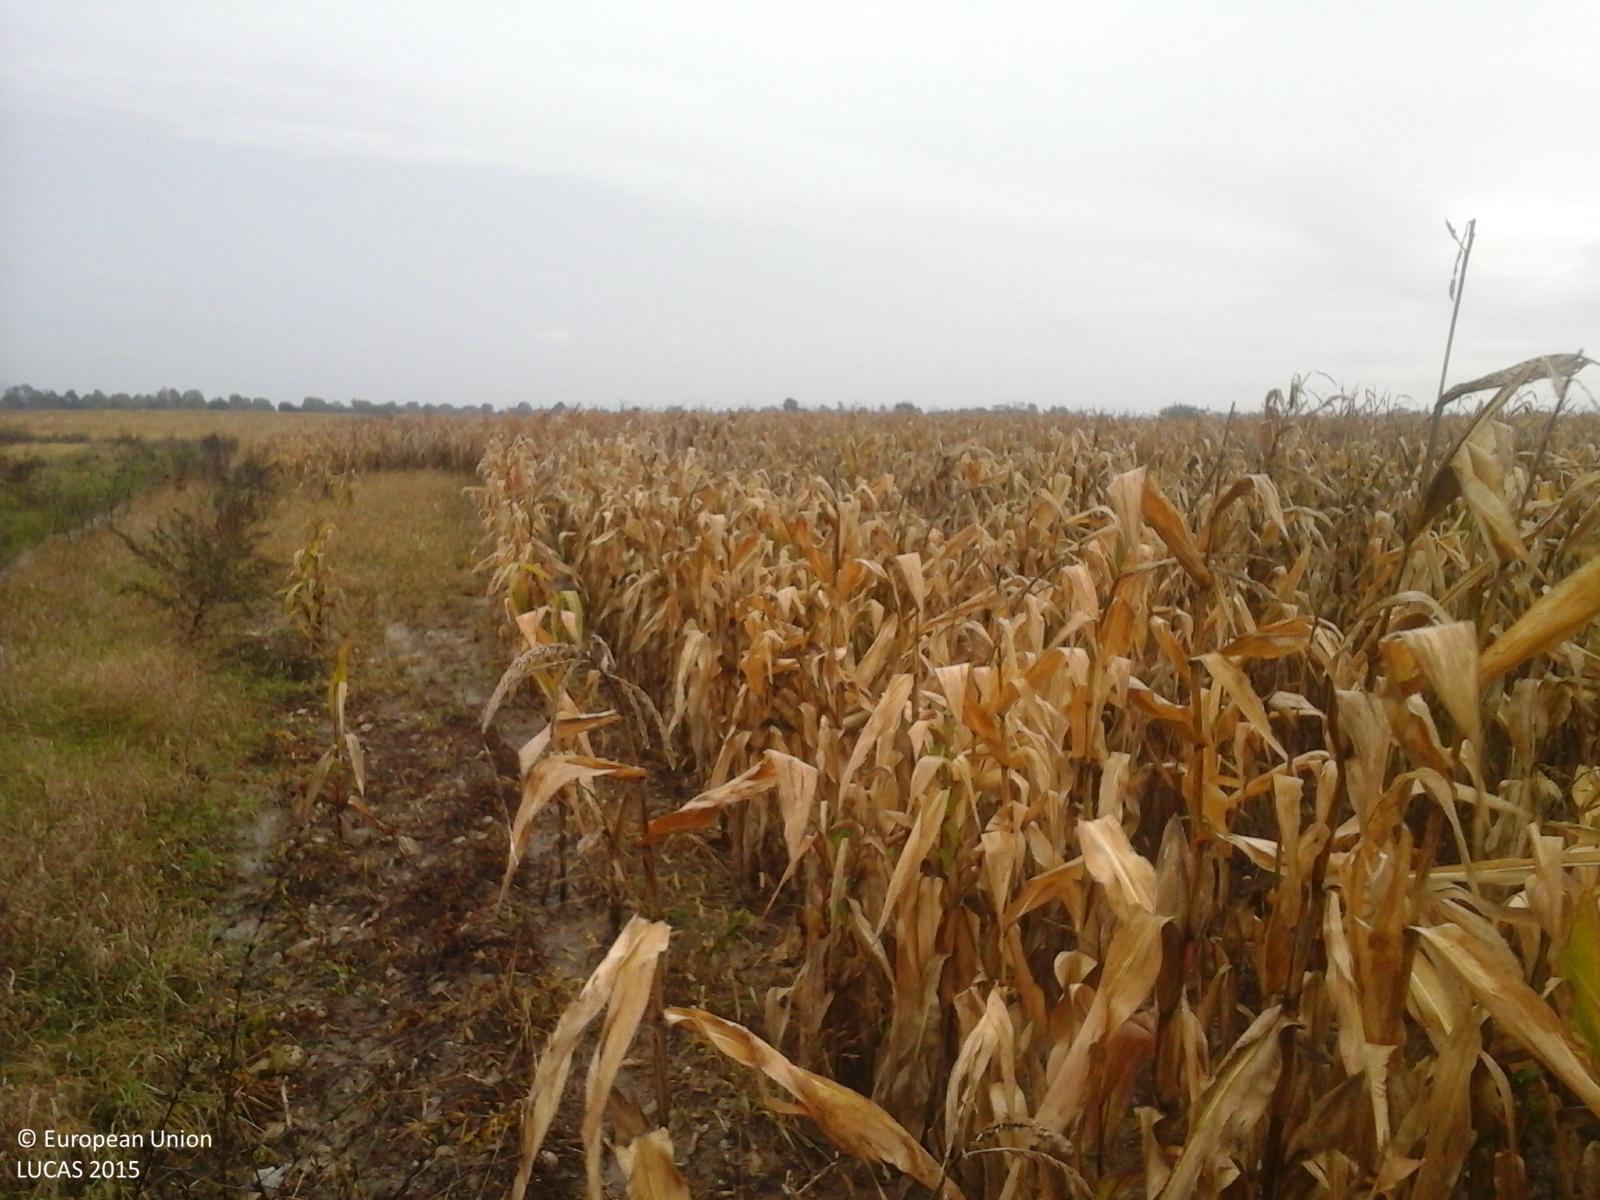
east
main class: Cropland
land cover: Maize
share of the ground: > 75 %
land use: Agriculture (excluding fallow land and kitchen gardens)
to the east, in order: Maize
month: October
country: RO
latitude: 45.7846
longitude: 24.7107
